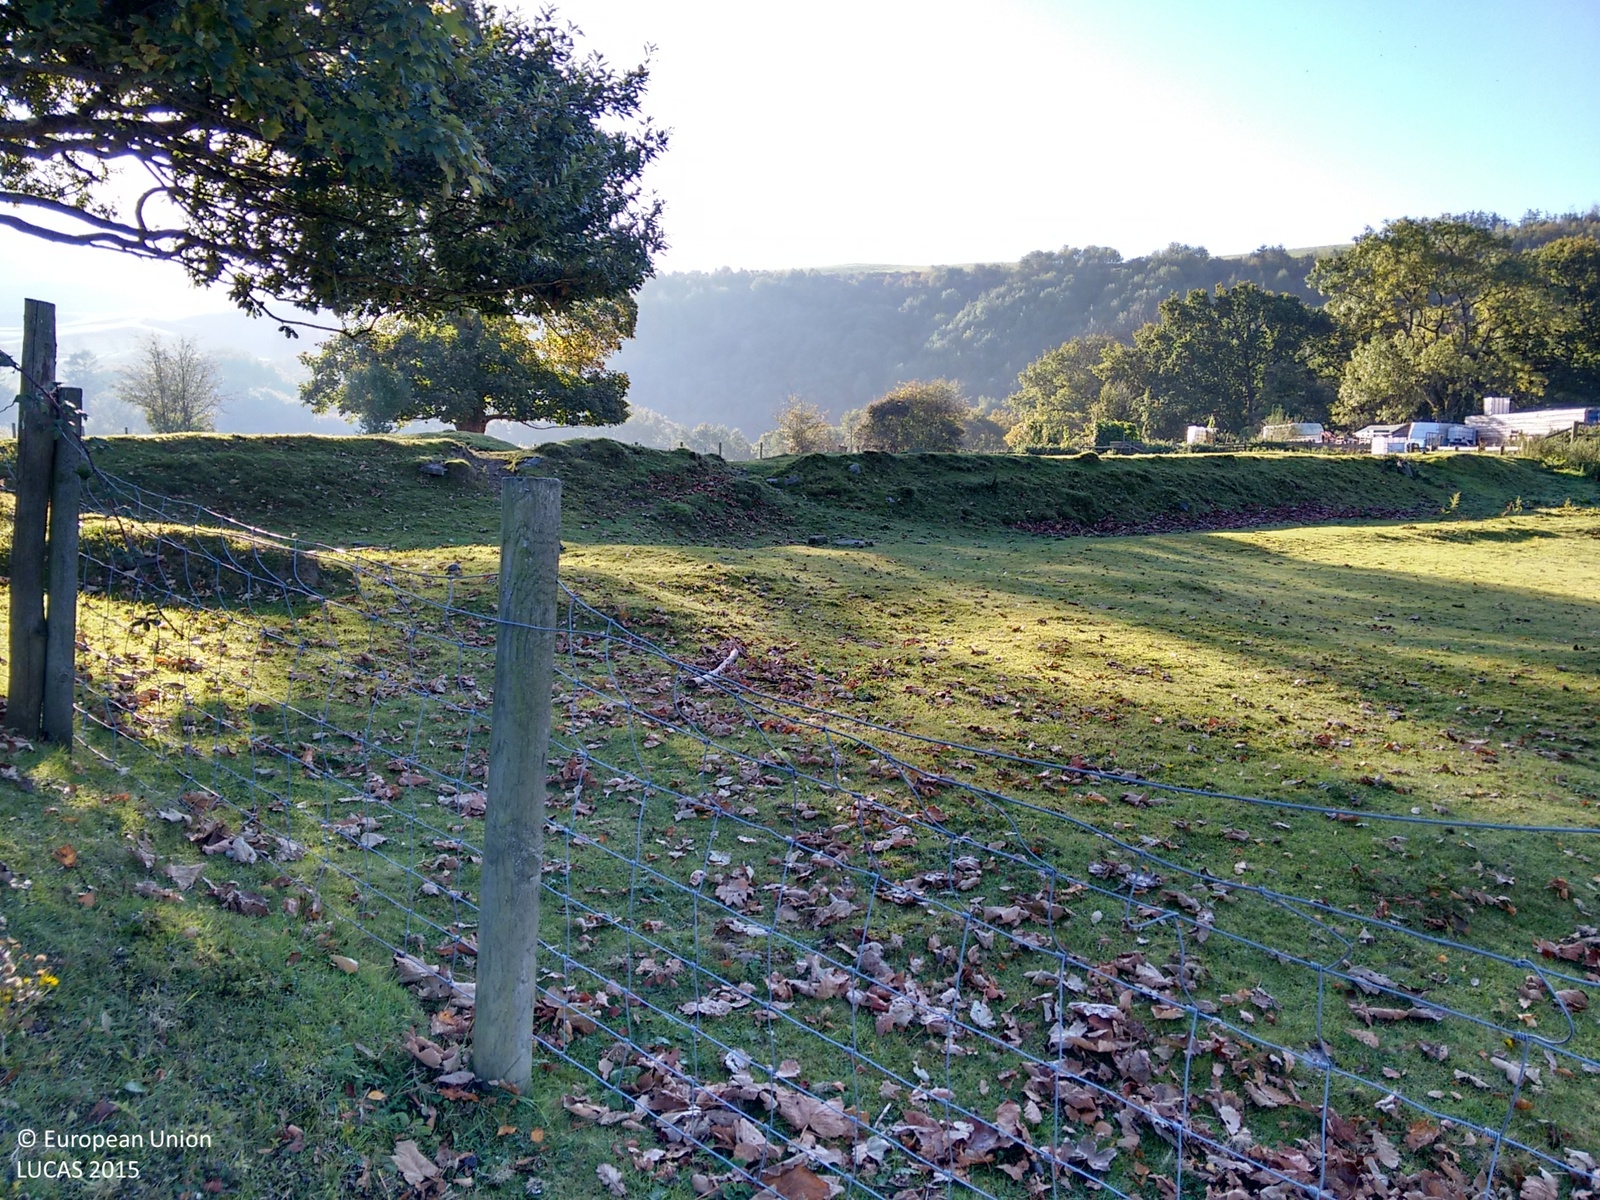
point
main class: Grassland
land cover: Grassland without tree/shrub cover
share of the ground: > 75 %
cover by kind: herbaceous plants 100 %
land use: Agriculture (excluding fallow land and kitchen gardens)
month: October
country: GB
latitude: 52.3531
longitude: -3.9382
